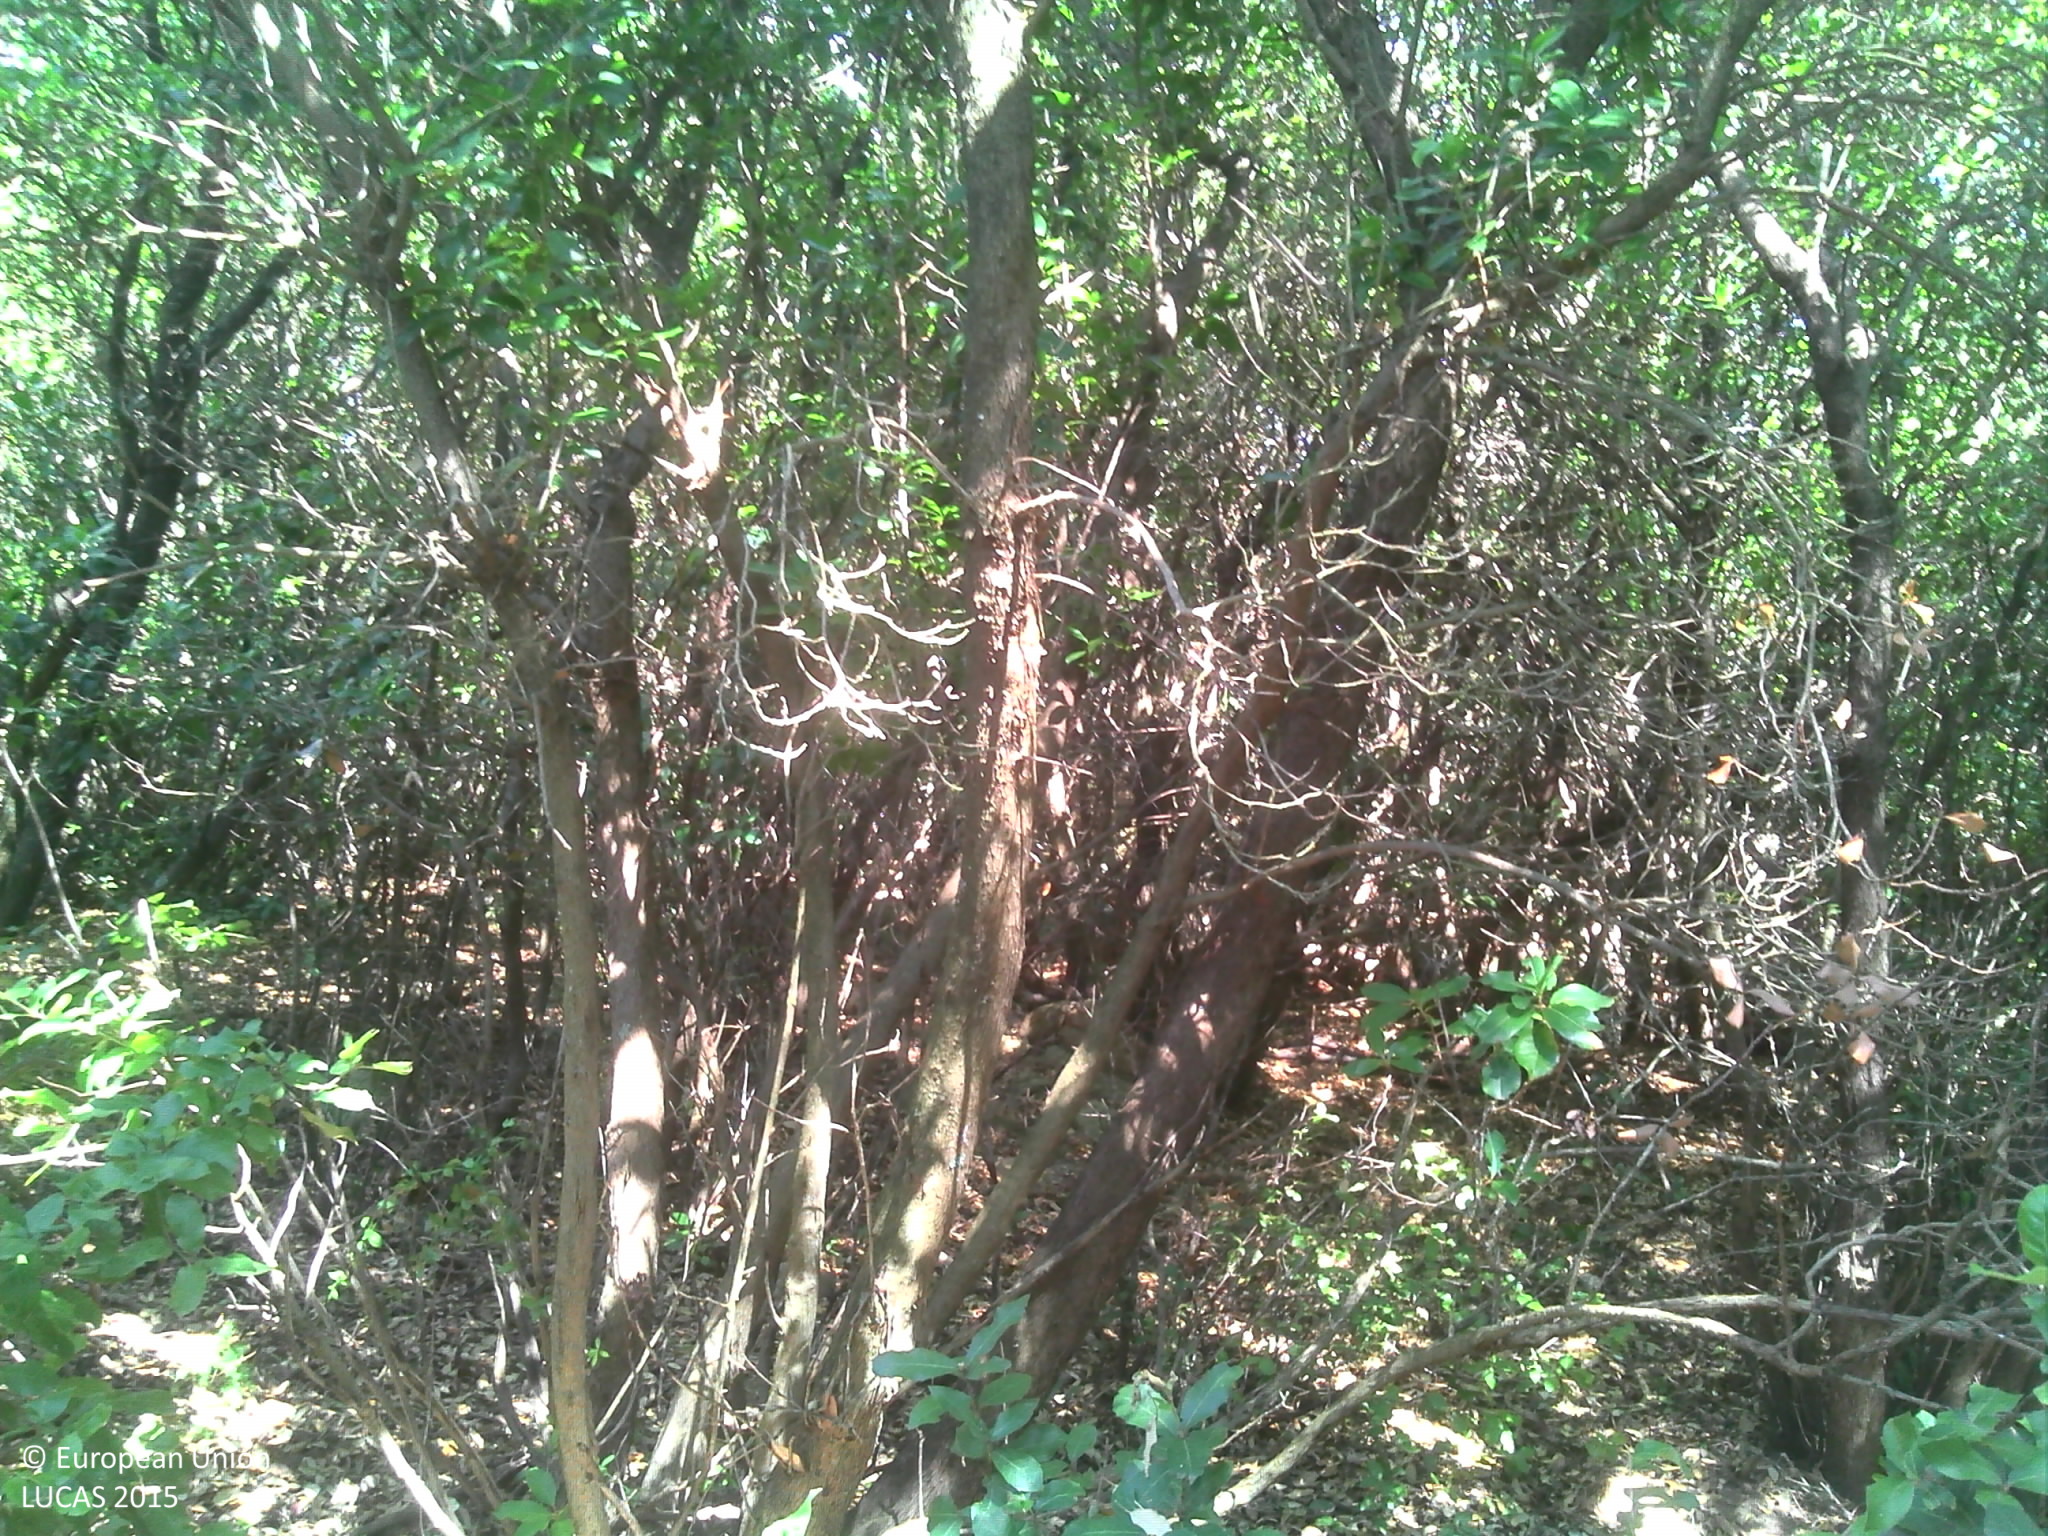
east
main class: Woodland
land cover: Broadleaved woodland
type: thermophilous deciduous forest
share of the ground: > 75 %
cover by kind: broadleaved forest trees 90 %, unconsolidated bare surface 10 %
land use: Semi-natural and natural areas not in use
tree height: > 5 m
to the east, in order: Broadleaved woodland
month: July
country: FR
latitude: 43.1677
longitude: 6.3809
